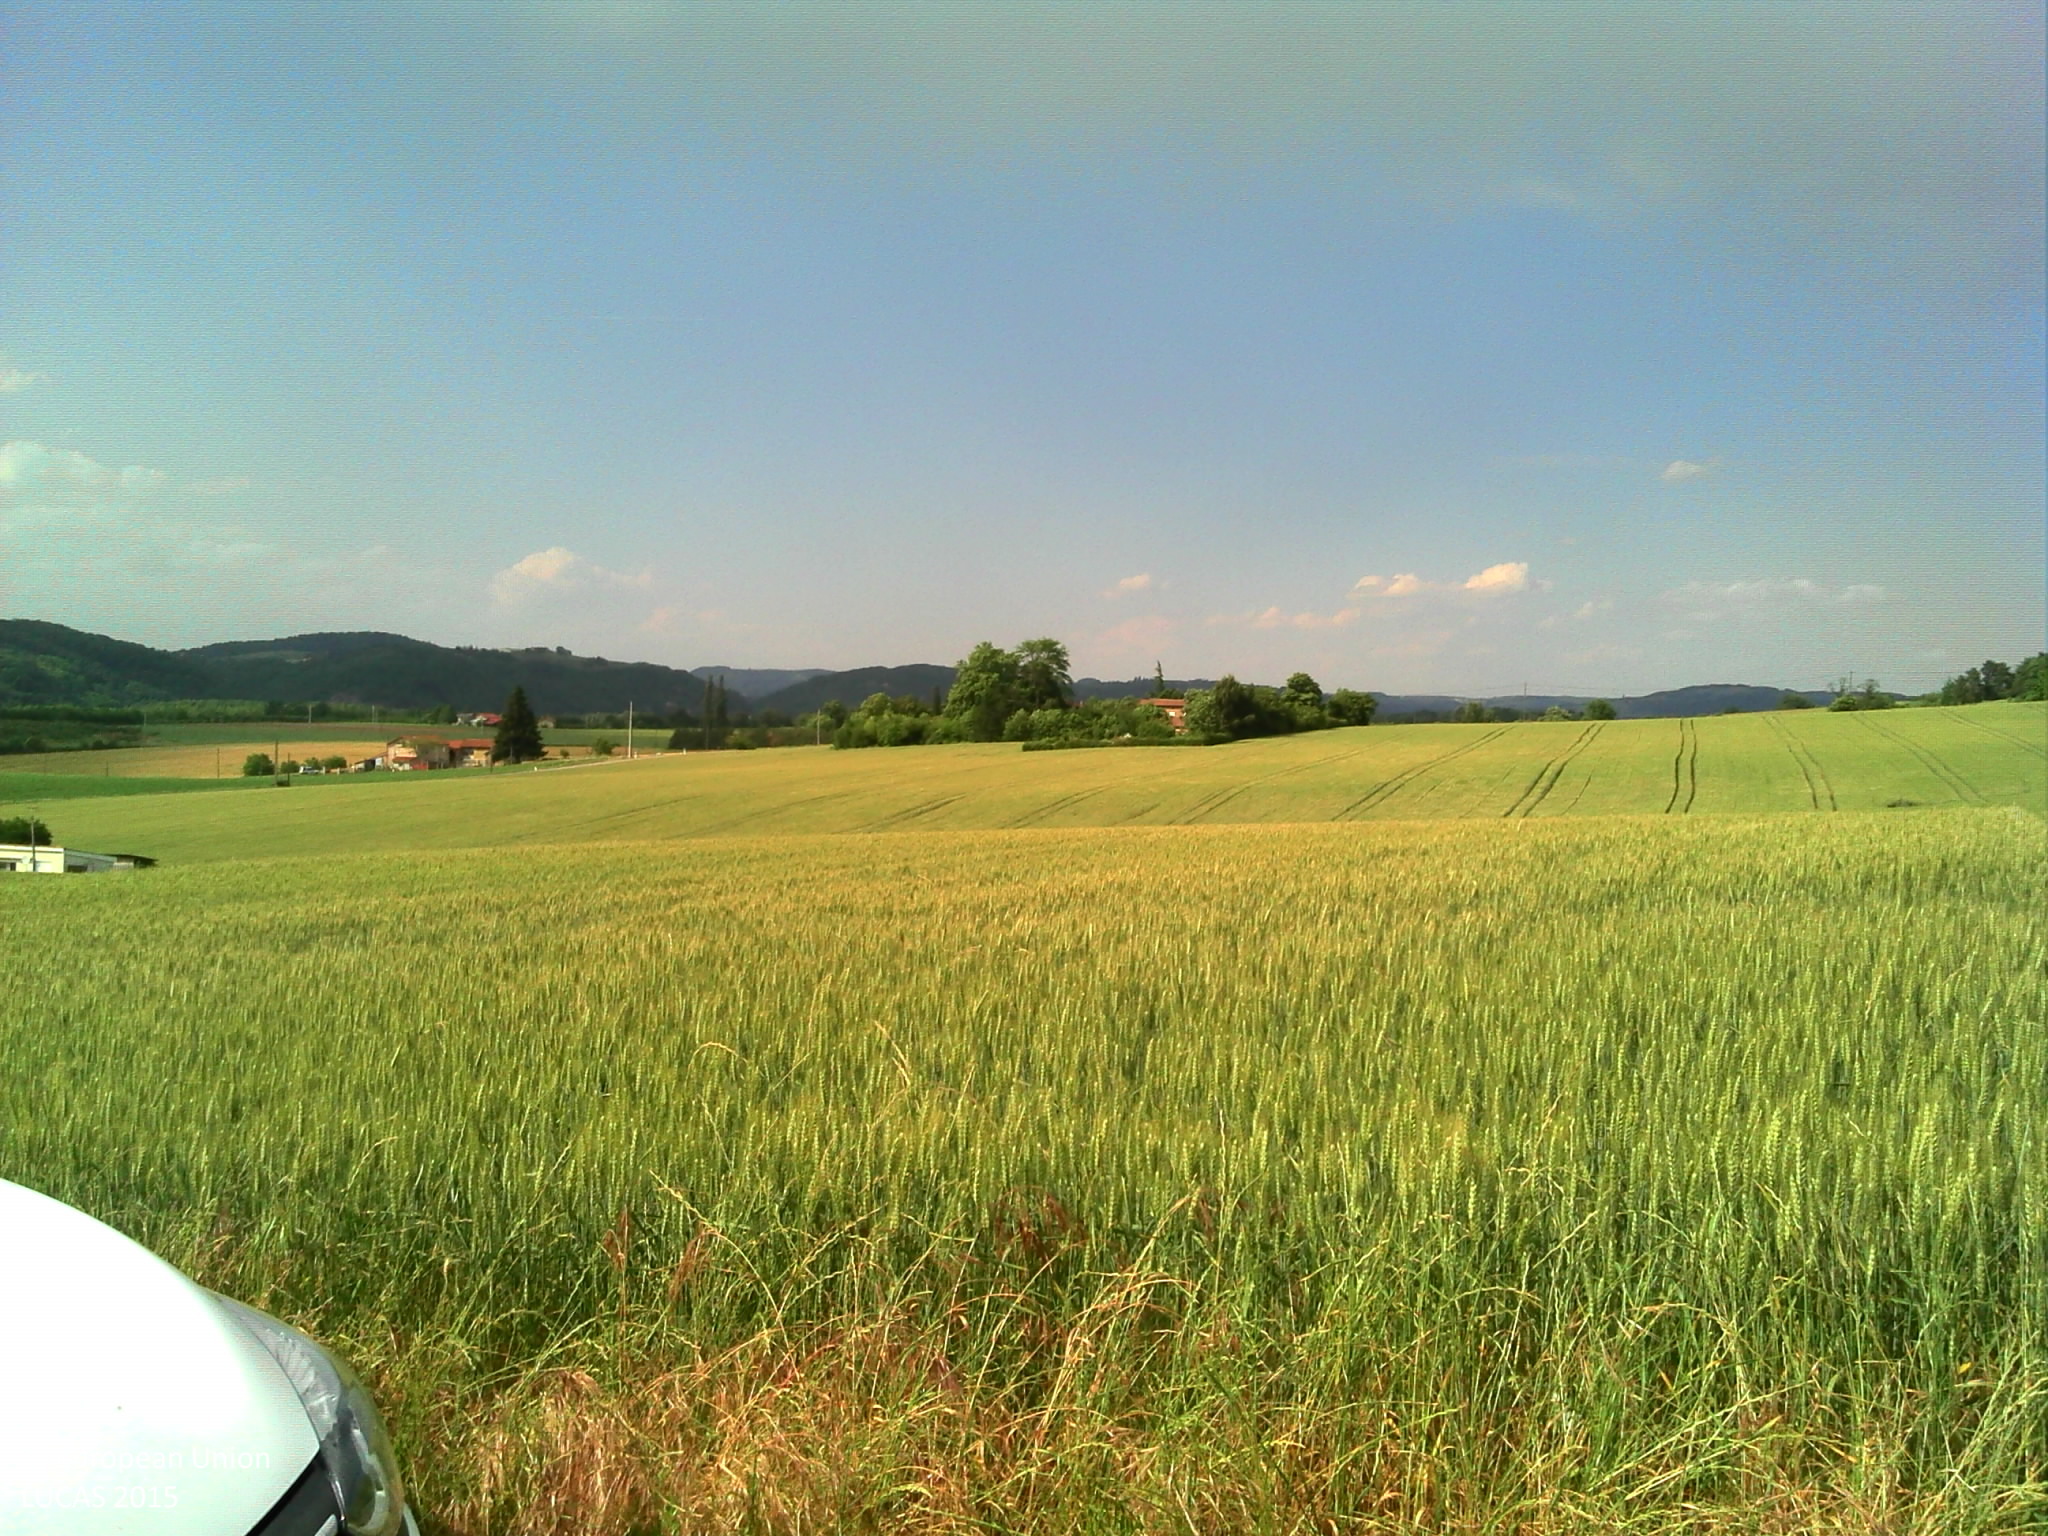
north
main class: Cropland
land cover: Durum wheat
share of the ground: > 75 %
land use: Agriculture (excluding fallow land and kitchen gardens)
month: May
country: FR
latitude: 45.1156
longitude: 5.0097
